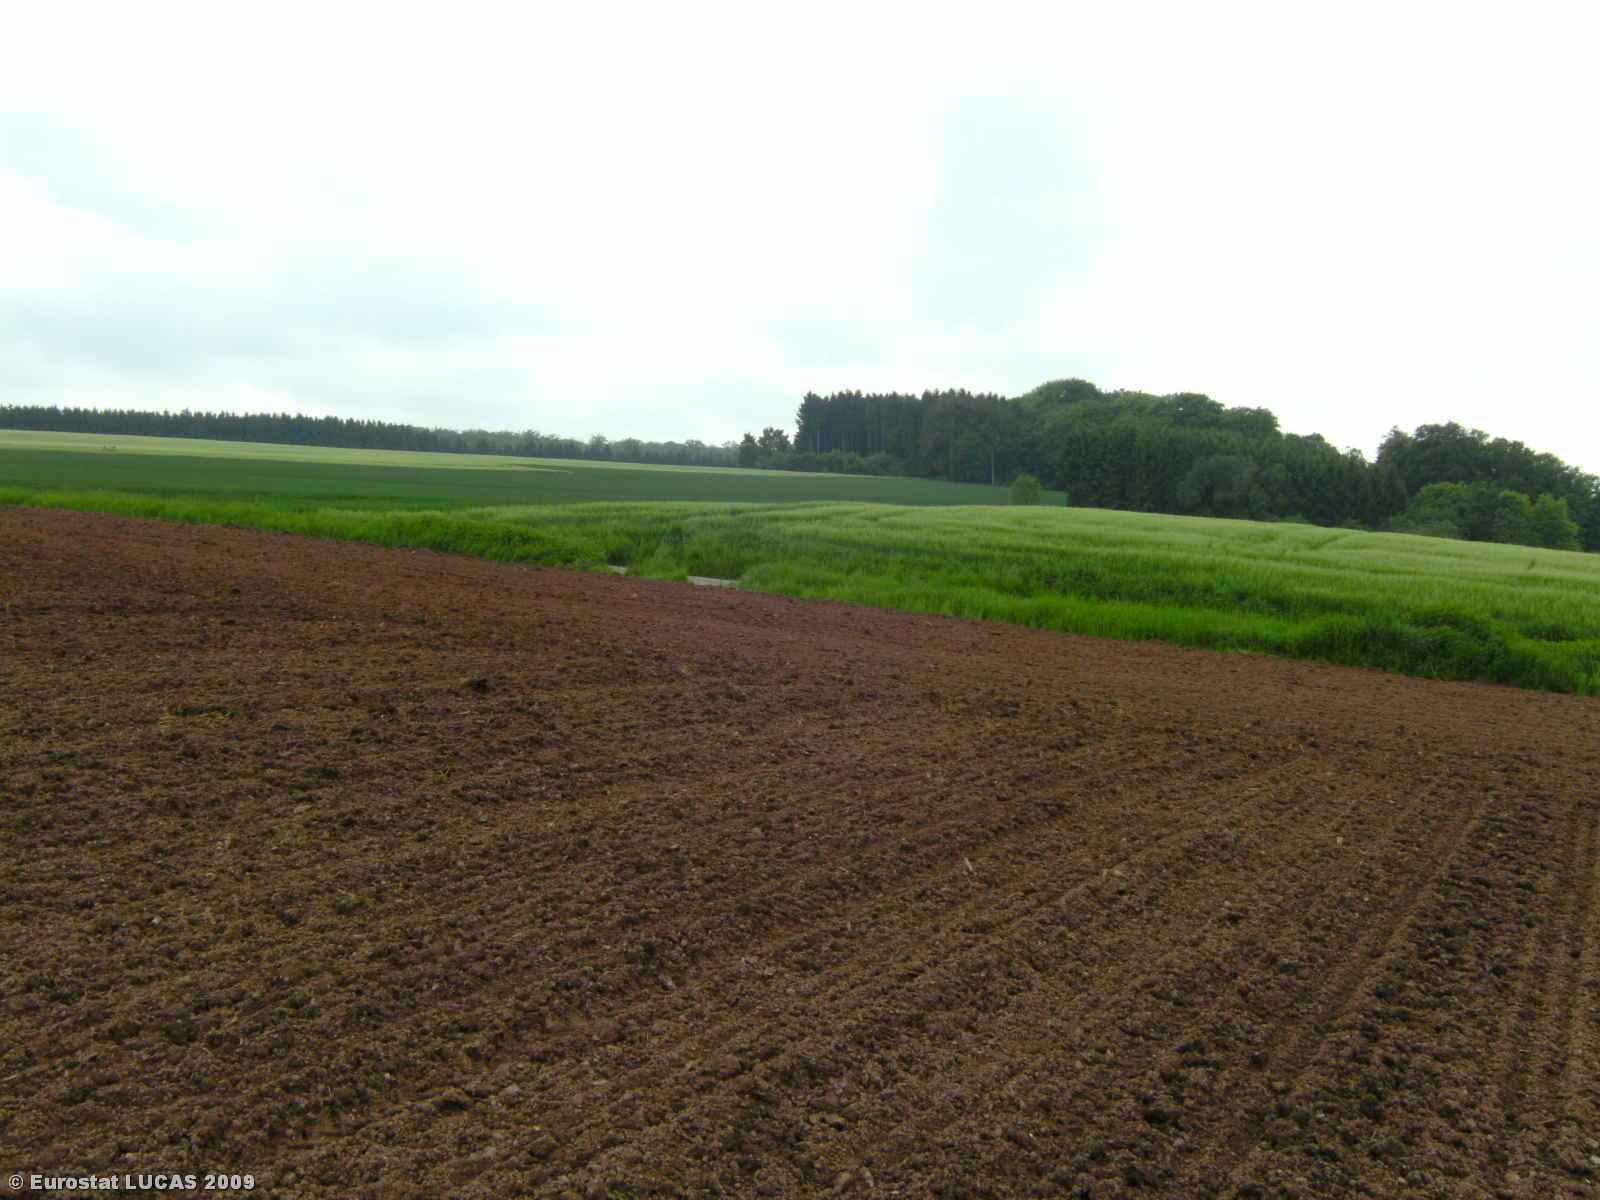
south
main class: Cropland
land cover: Maize
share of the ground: > 75 %
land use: Agriculture (excluding fallow land and kitchen gardens)
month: May
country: LU
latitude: 49.7943
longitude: 6.1235
